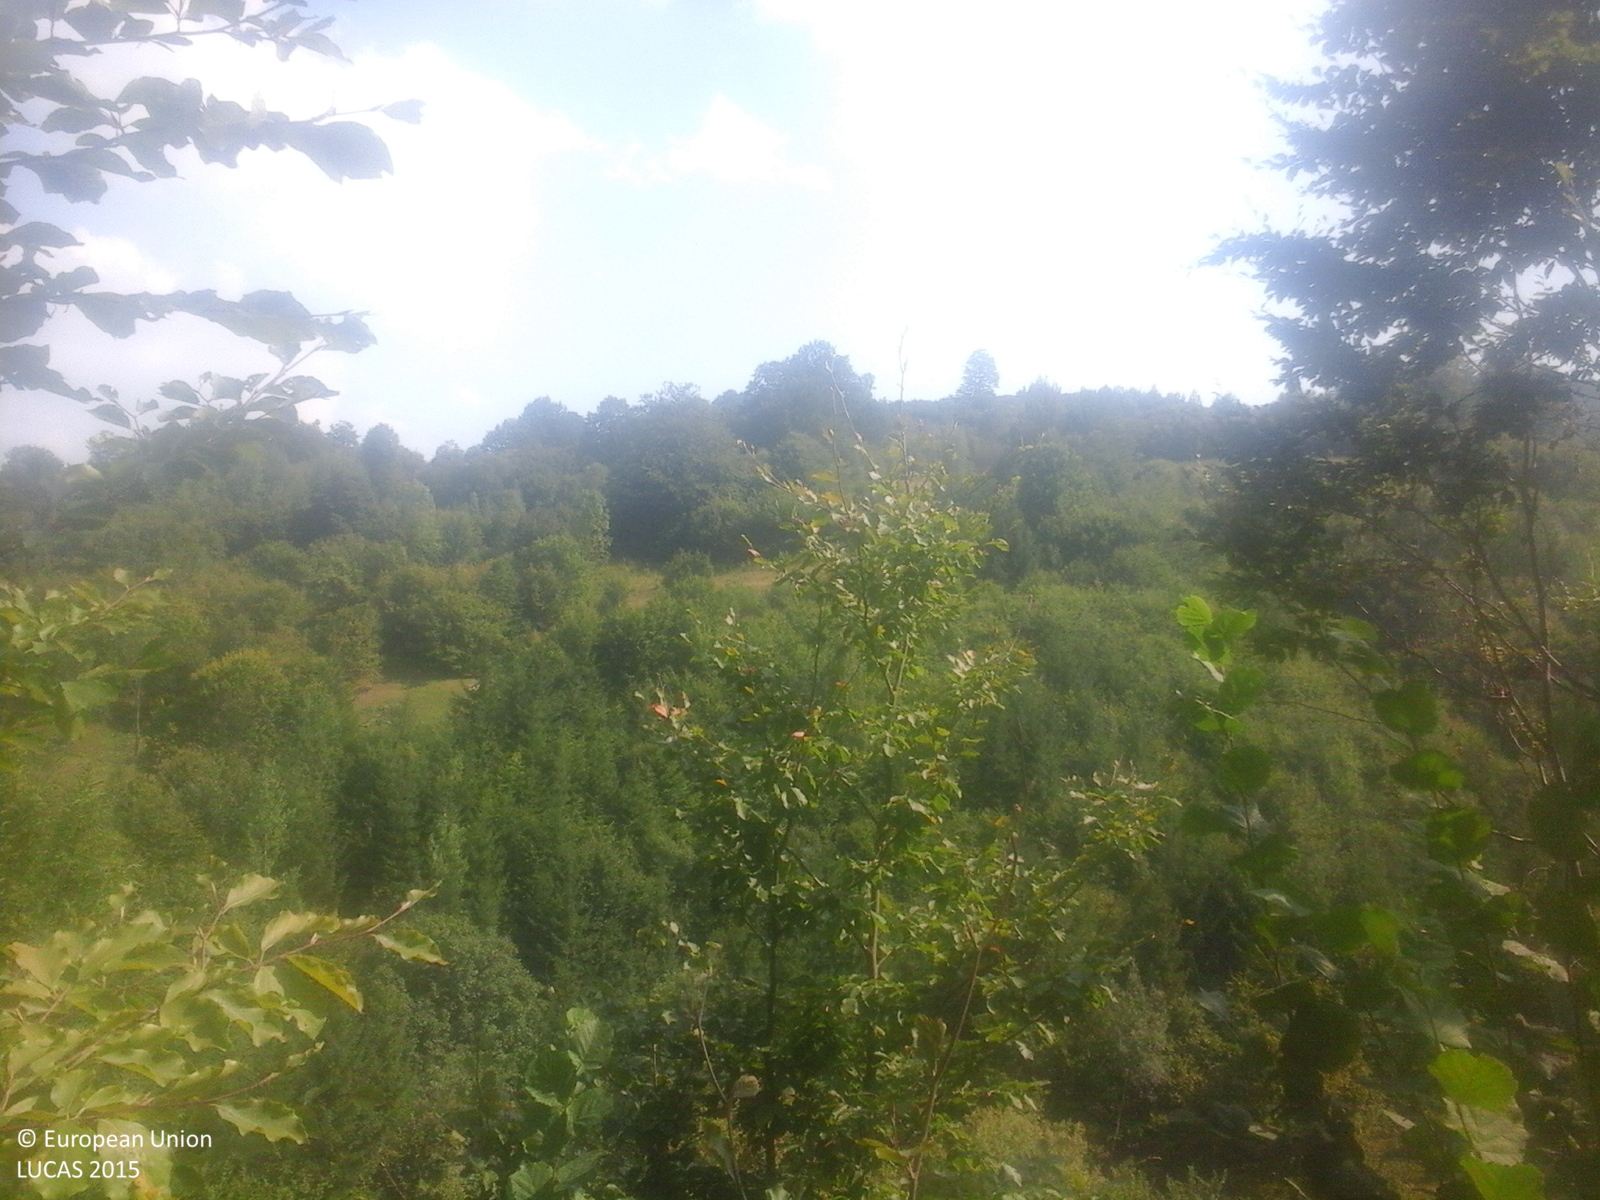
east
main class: Woodland
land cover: Other mixed woodland
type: beech forest
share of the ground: > 75 %
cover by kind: broadleaved forest trees 70 %, coniferous forest trees 30 %
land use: Forestry
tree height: > 5 m
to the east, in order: Other mixed woodland; Grassland without tree/shrub cover; Lines of trees; Tracks; Other mixed woodland; Rivers and streams; Other mixed woodland; Grassland without tree/shrub cover; Other mixed woodland; Grassland without tree/shrub cover; Other mixed woodland
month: September
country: RO
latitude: 47.6056
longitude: 24.3641
